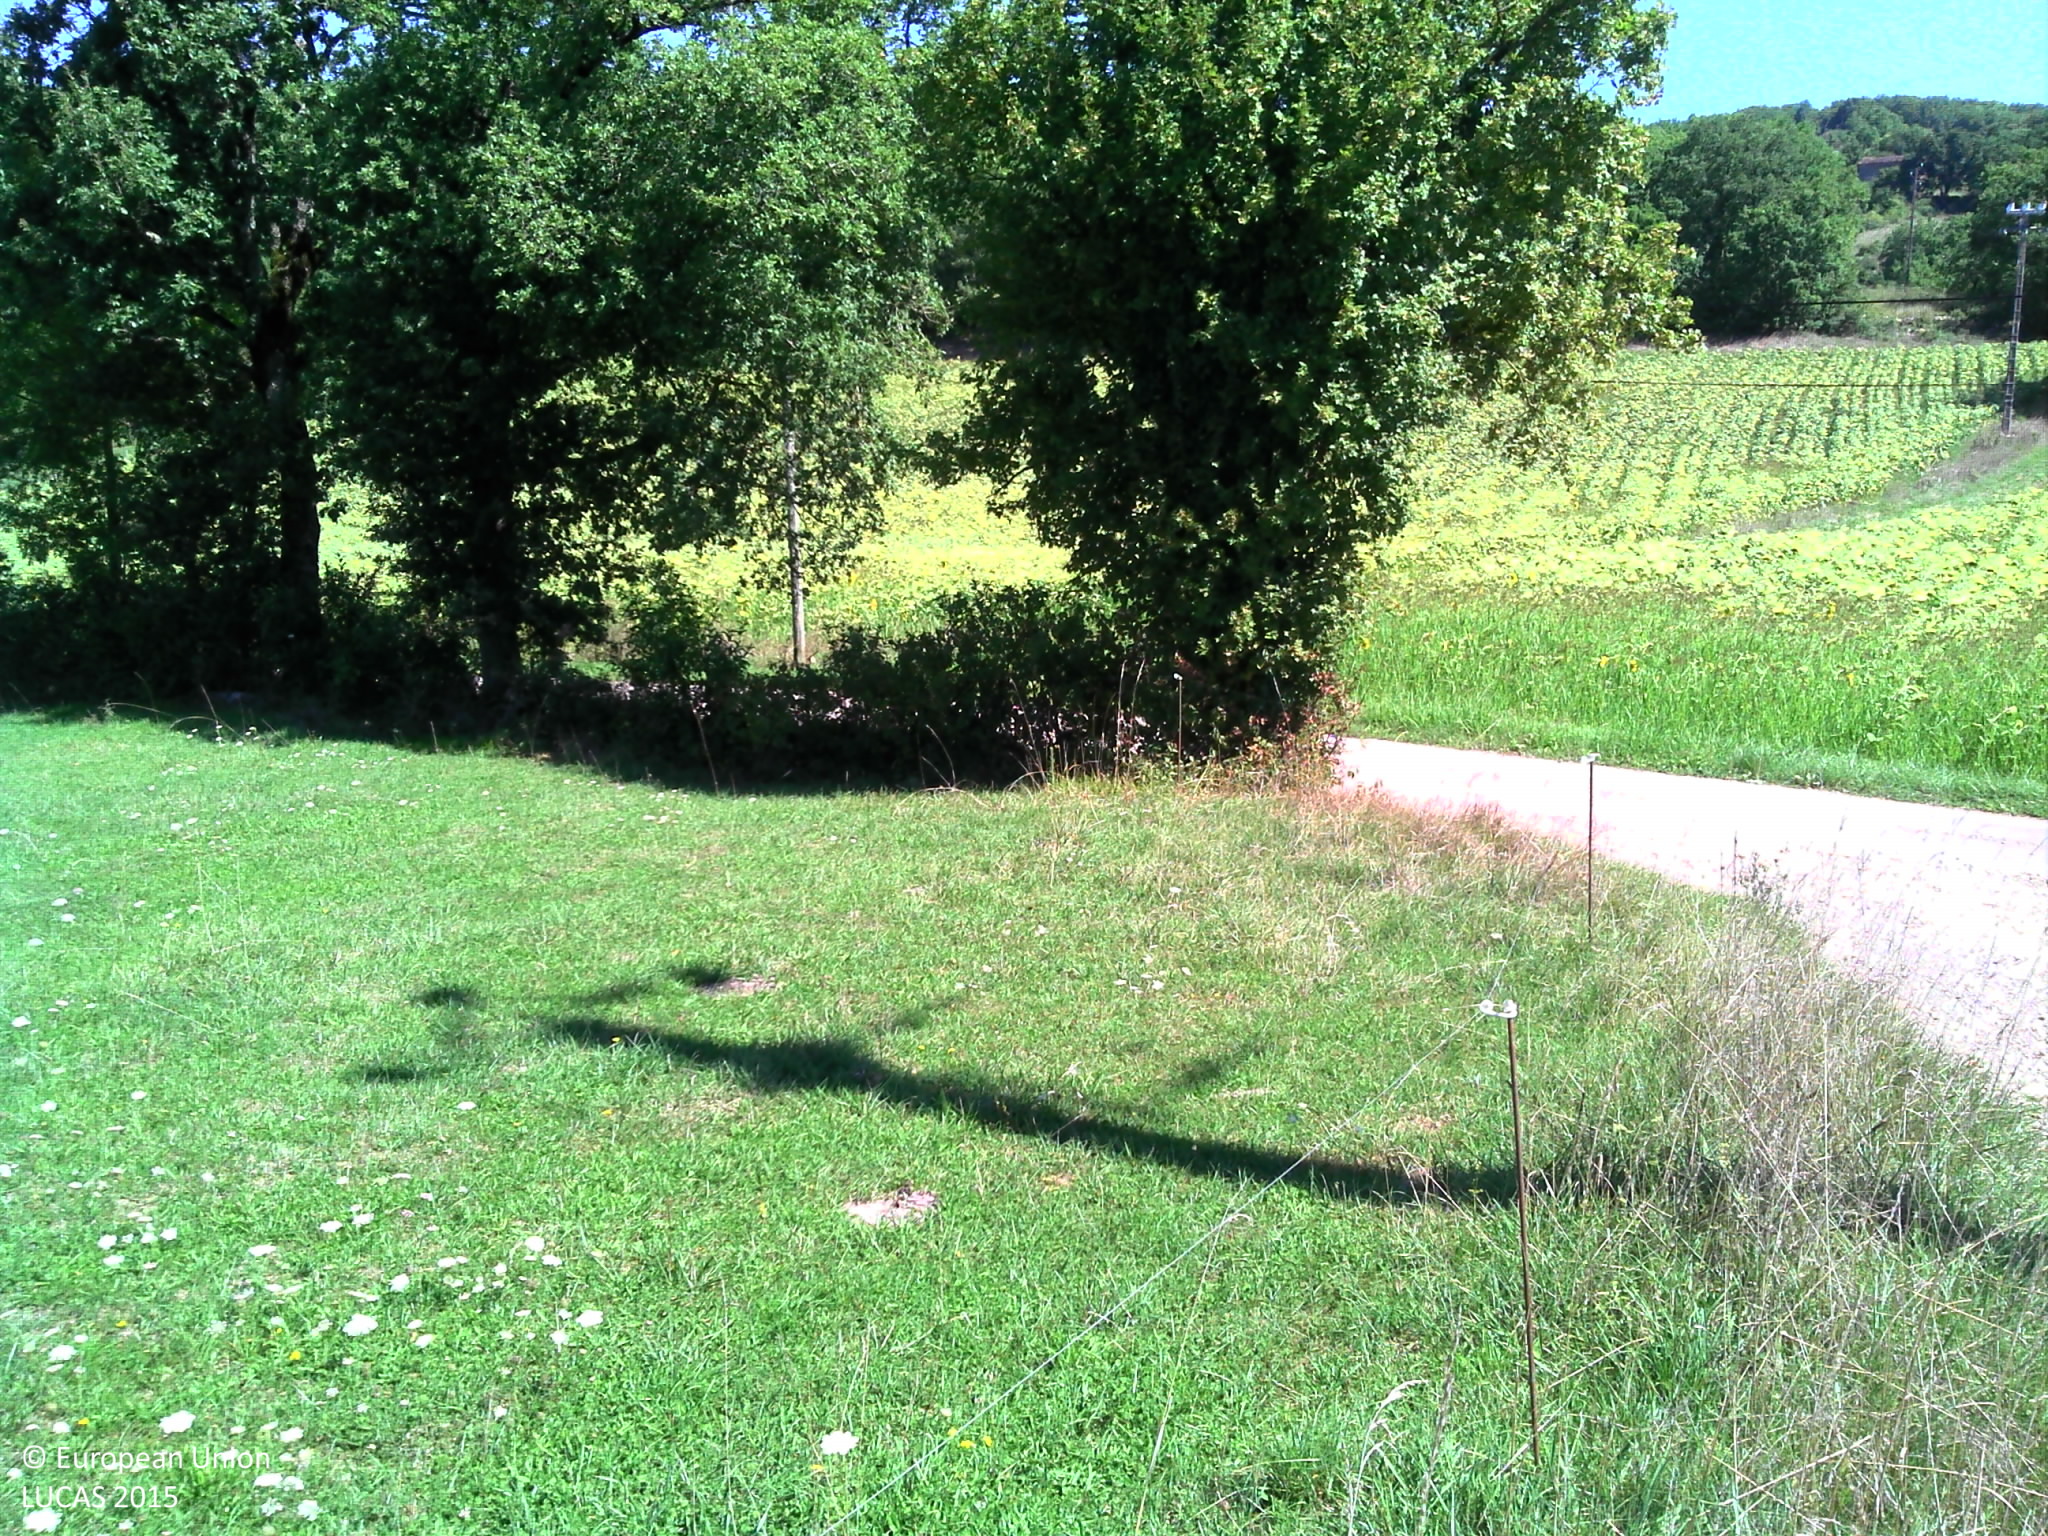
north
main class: Grassland
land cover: Grassland without tree/shrub cover
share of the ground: > 75 %
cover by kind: herbaceous plants 100 %
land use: Agriculture (excluding fallow land and kitchen gardens)
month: August
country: FR
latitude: 44.1792
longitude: 1.9086
